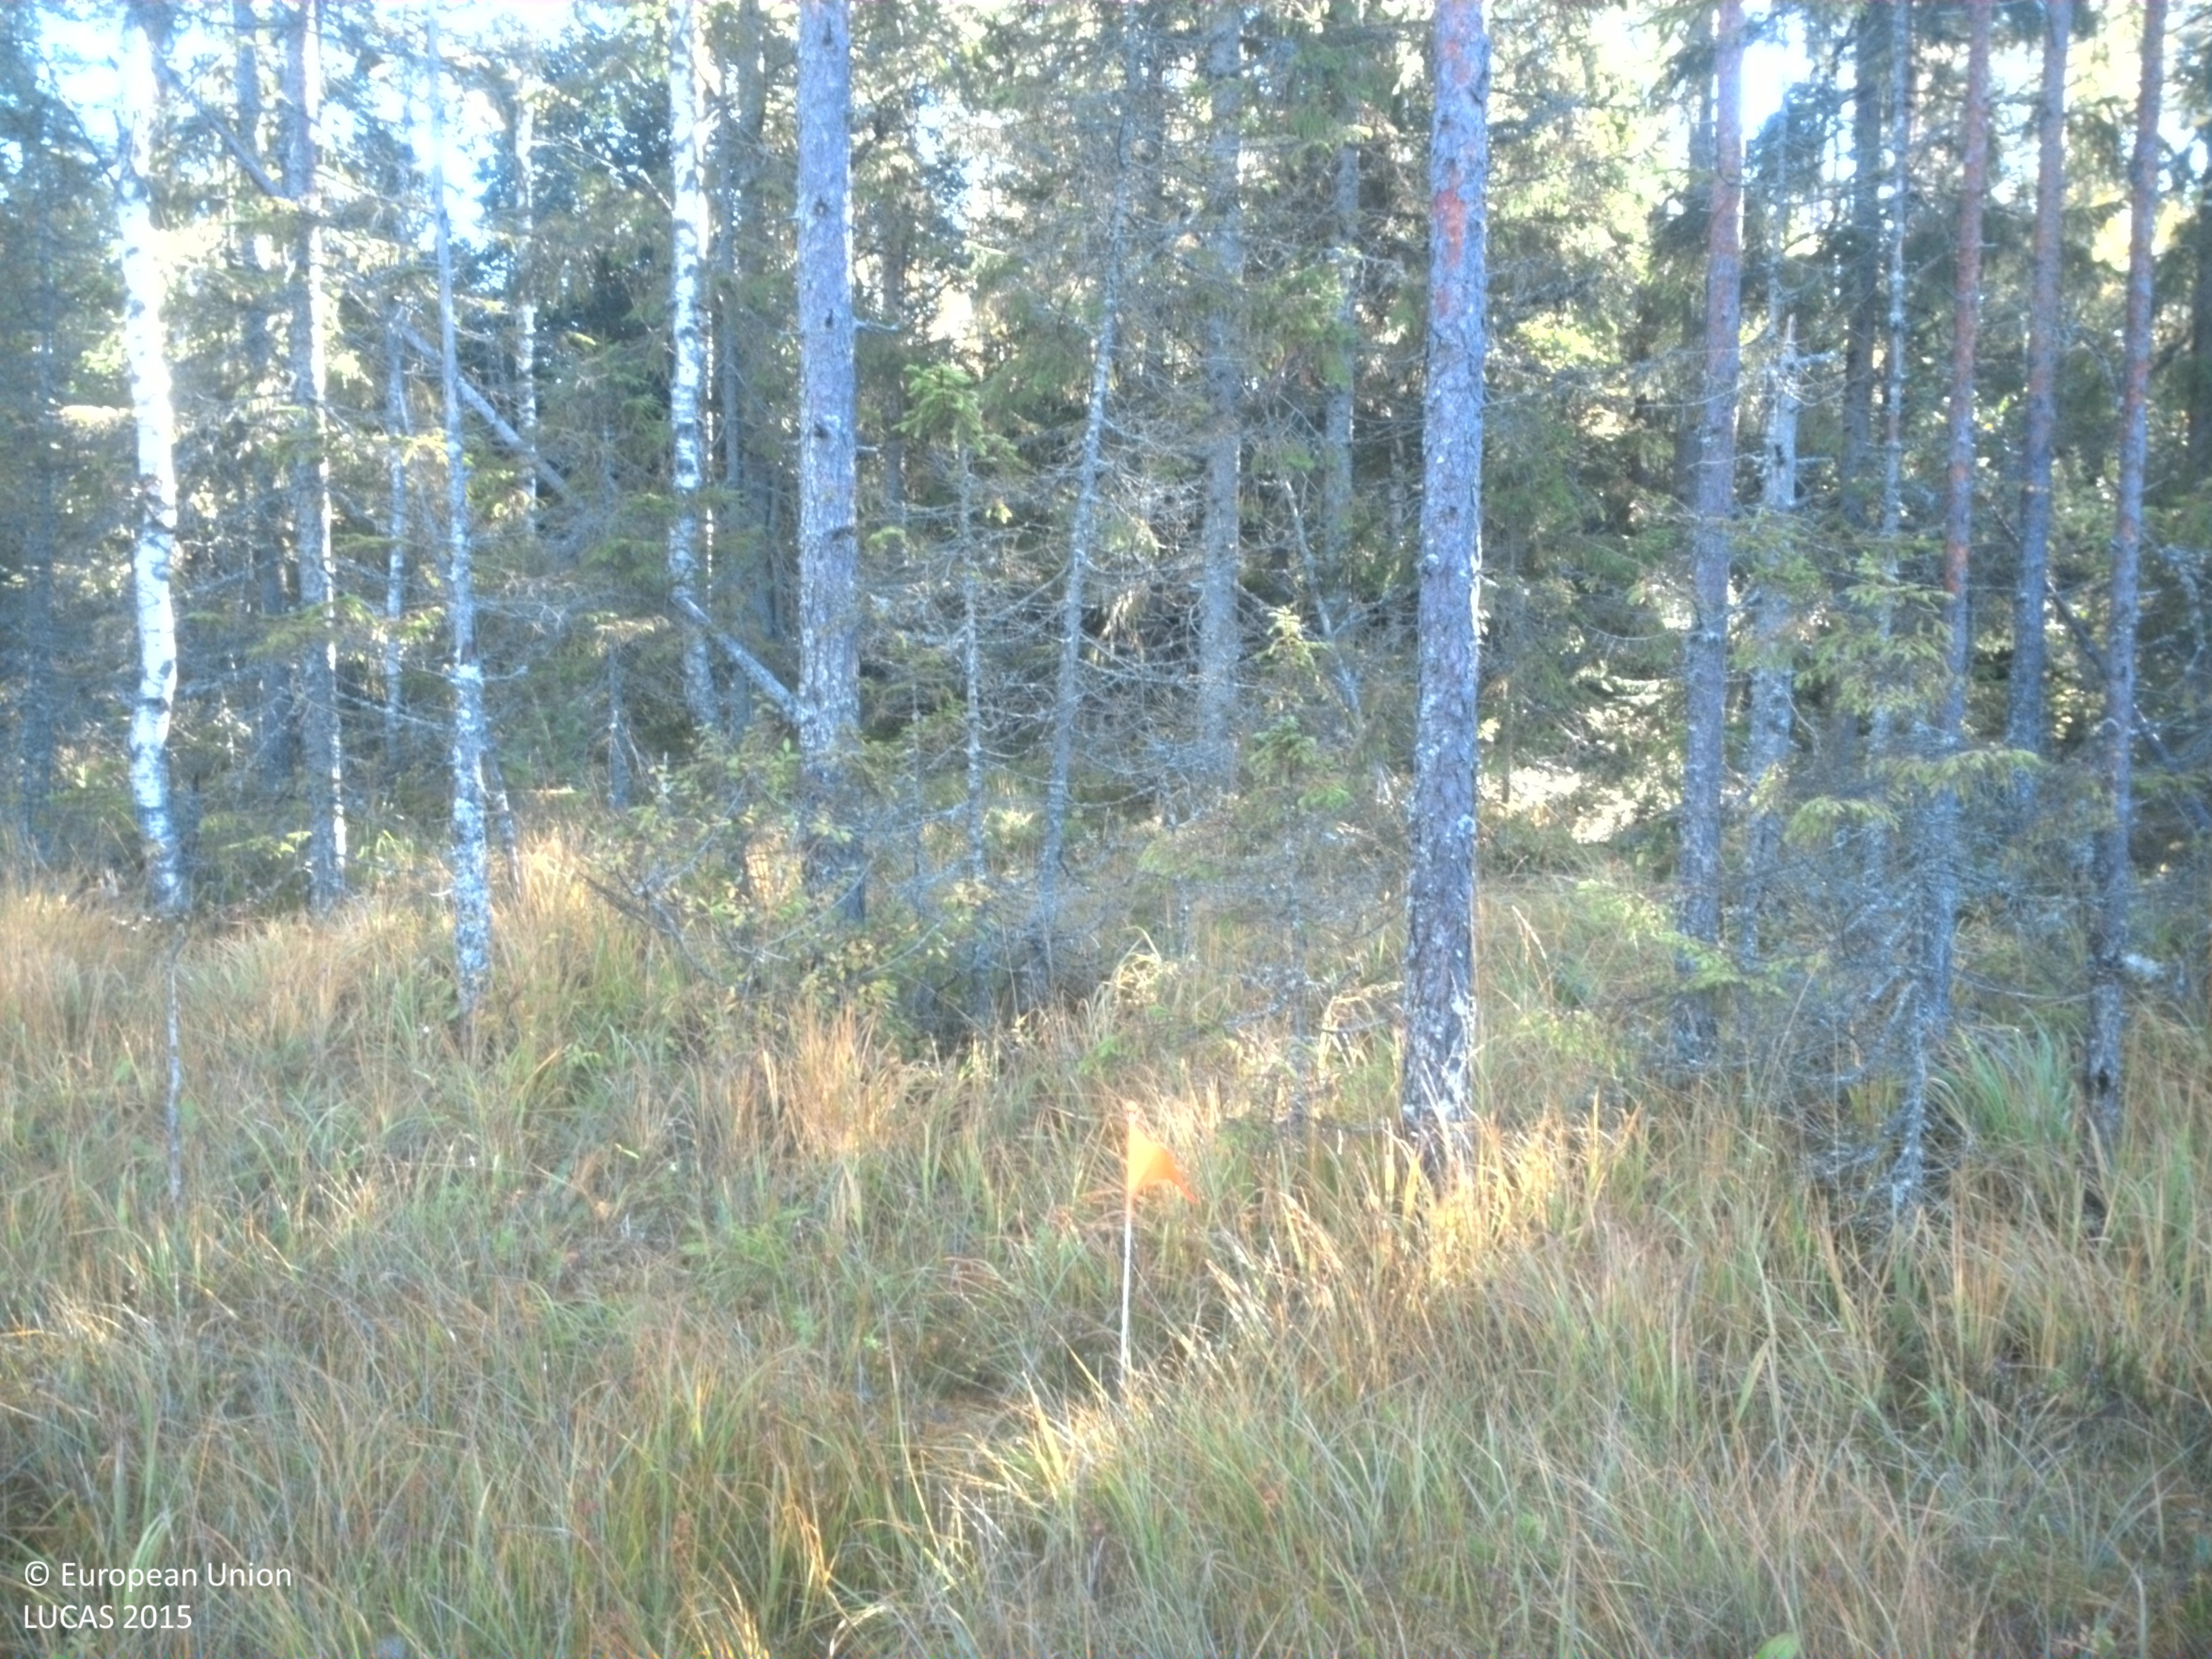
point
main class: Woodland
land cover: Other mixed woodland
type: mire and swamp forests
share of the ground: 50 - 75 %
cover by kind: coniferous forest trees 45 %, broadleaved forest trees 15 %, herbaceous plants 15 %, lichens and mosses 15 %, shrubs 10 %
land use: Forestry
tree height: > 5 m
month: September
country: SE
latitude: 59.9047
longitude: 15.1924
